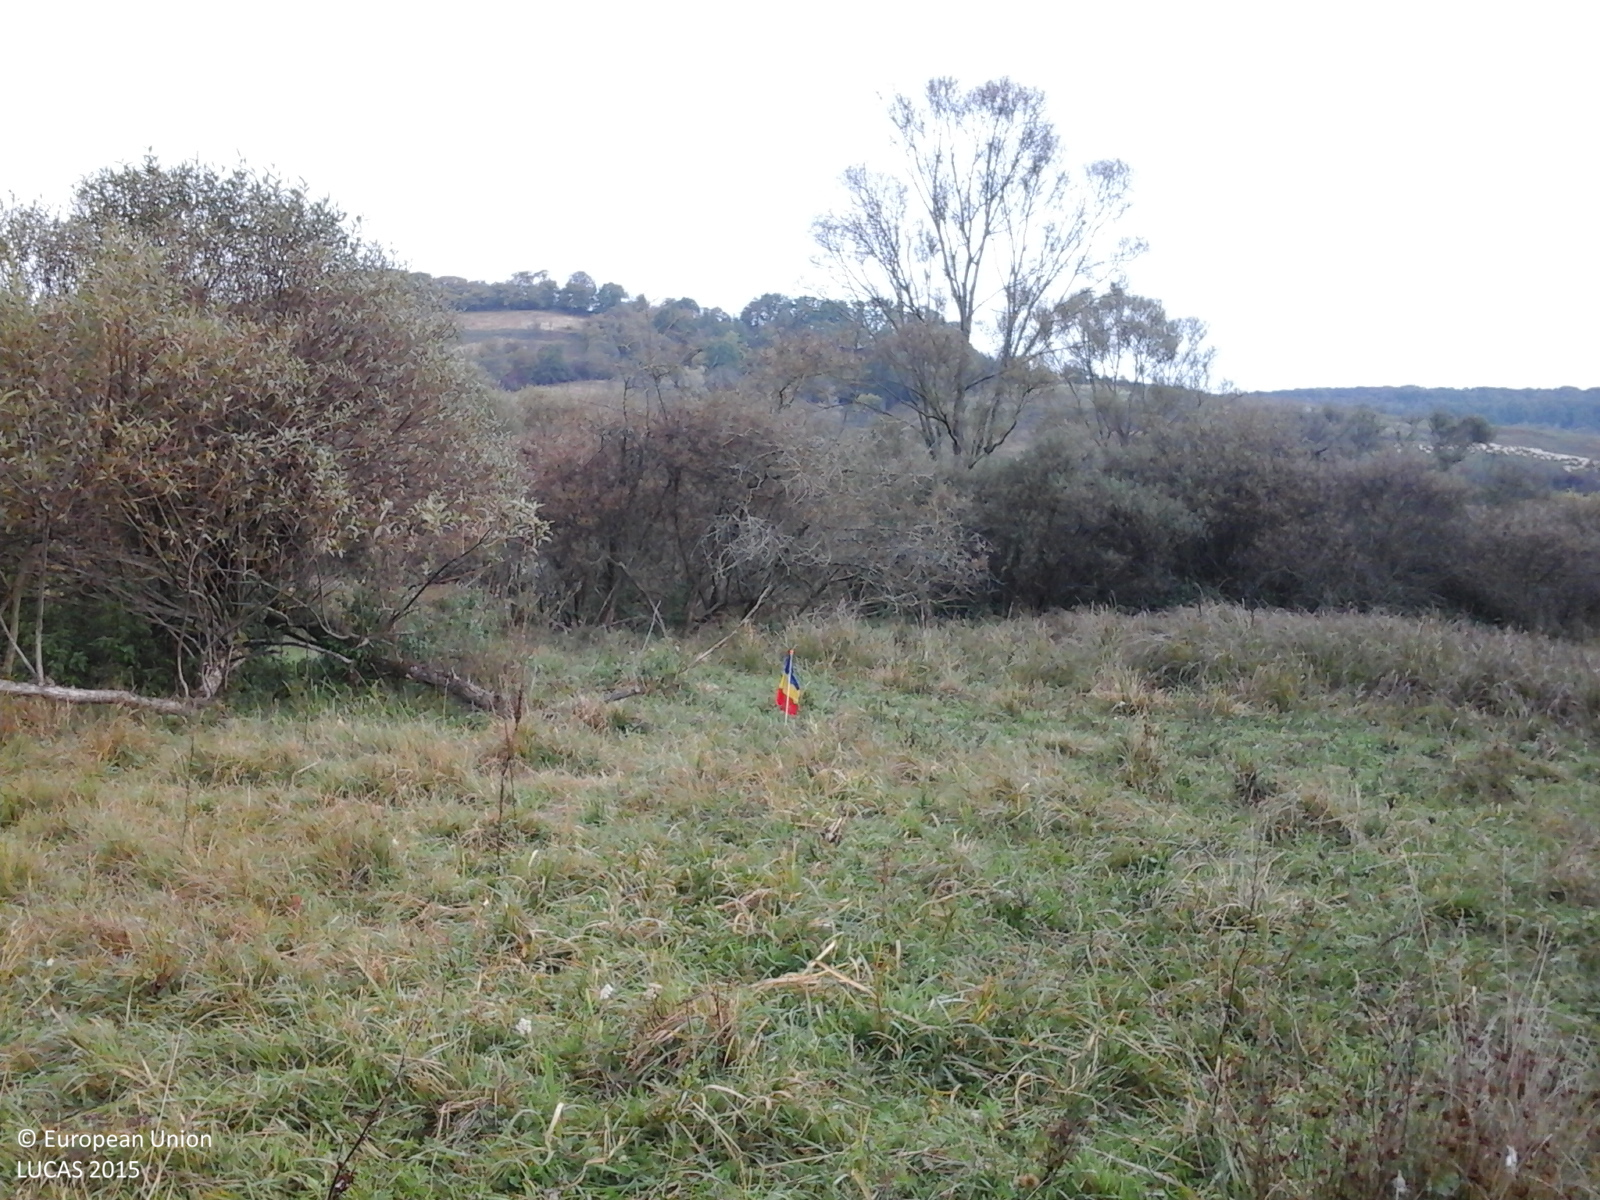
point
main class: Grassland
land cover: Grassland with sparse tree/shrub cover
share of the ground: > 75 %
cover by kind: herbaceous plants 95 %, broadleaved forest trees 5 %
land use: Agriculture (excluding fallow land and kitchen gardens)
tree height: > 5 m
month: October
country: RO
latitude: 46.0031
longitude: 24.7183
